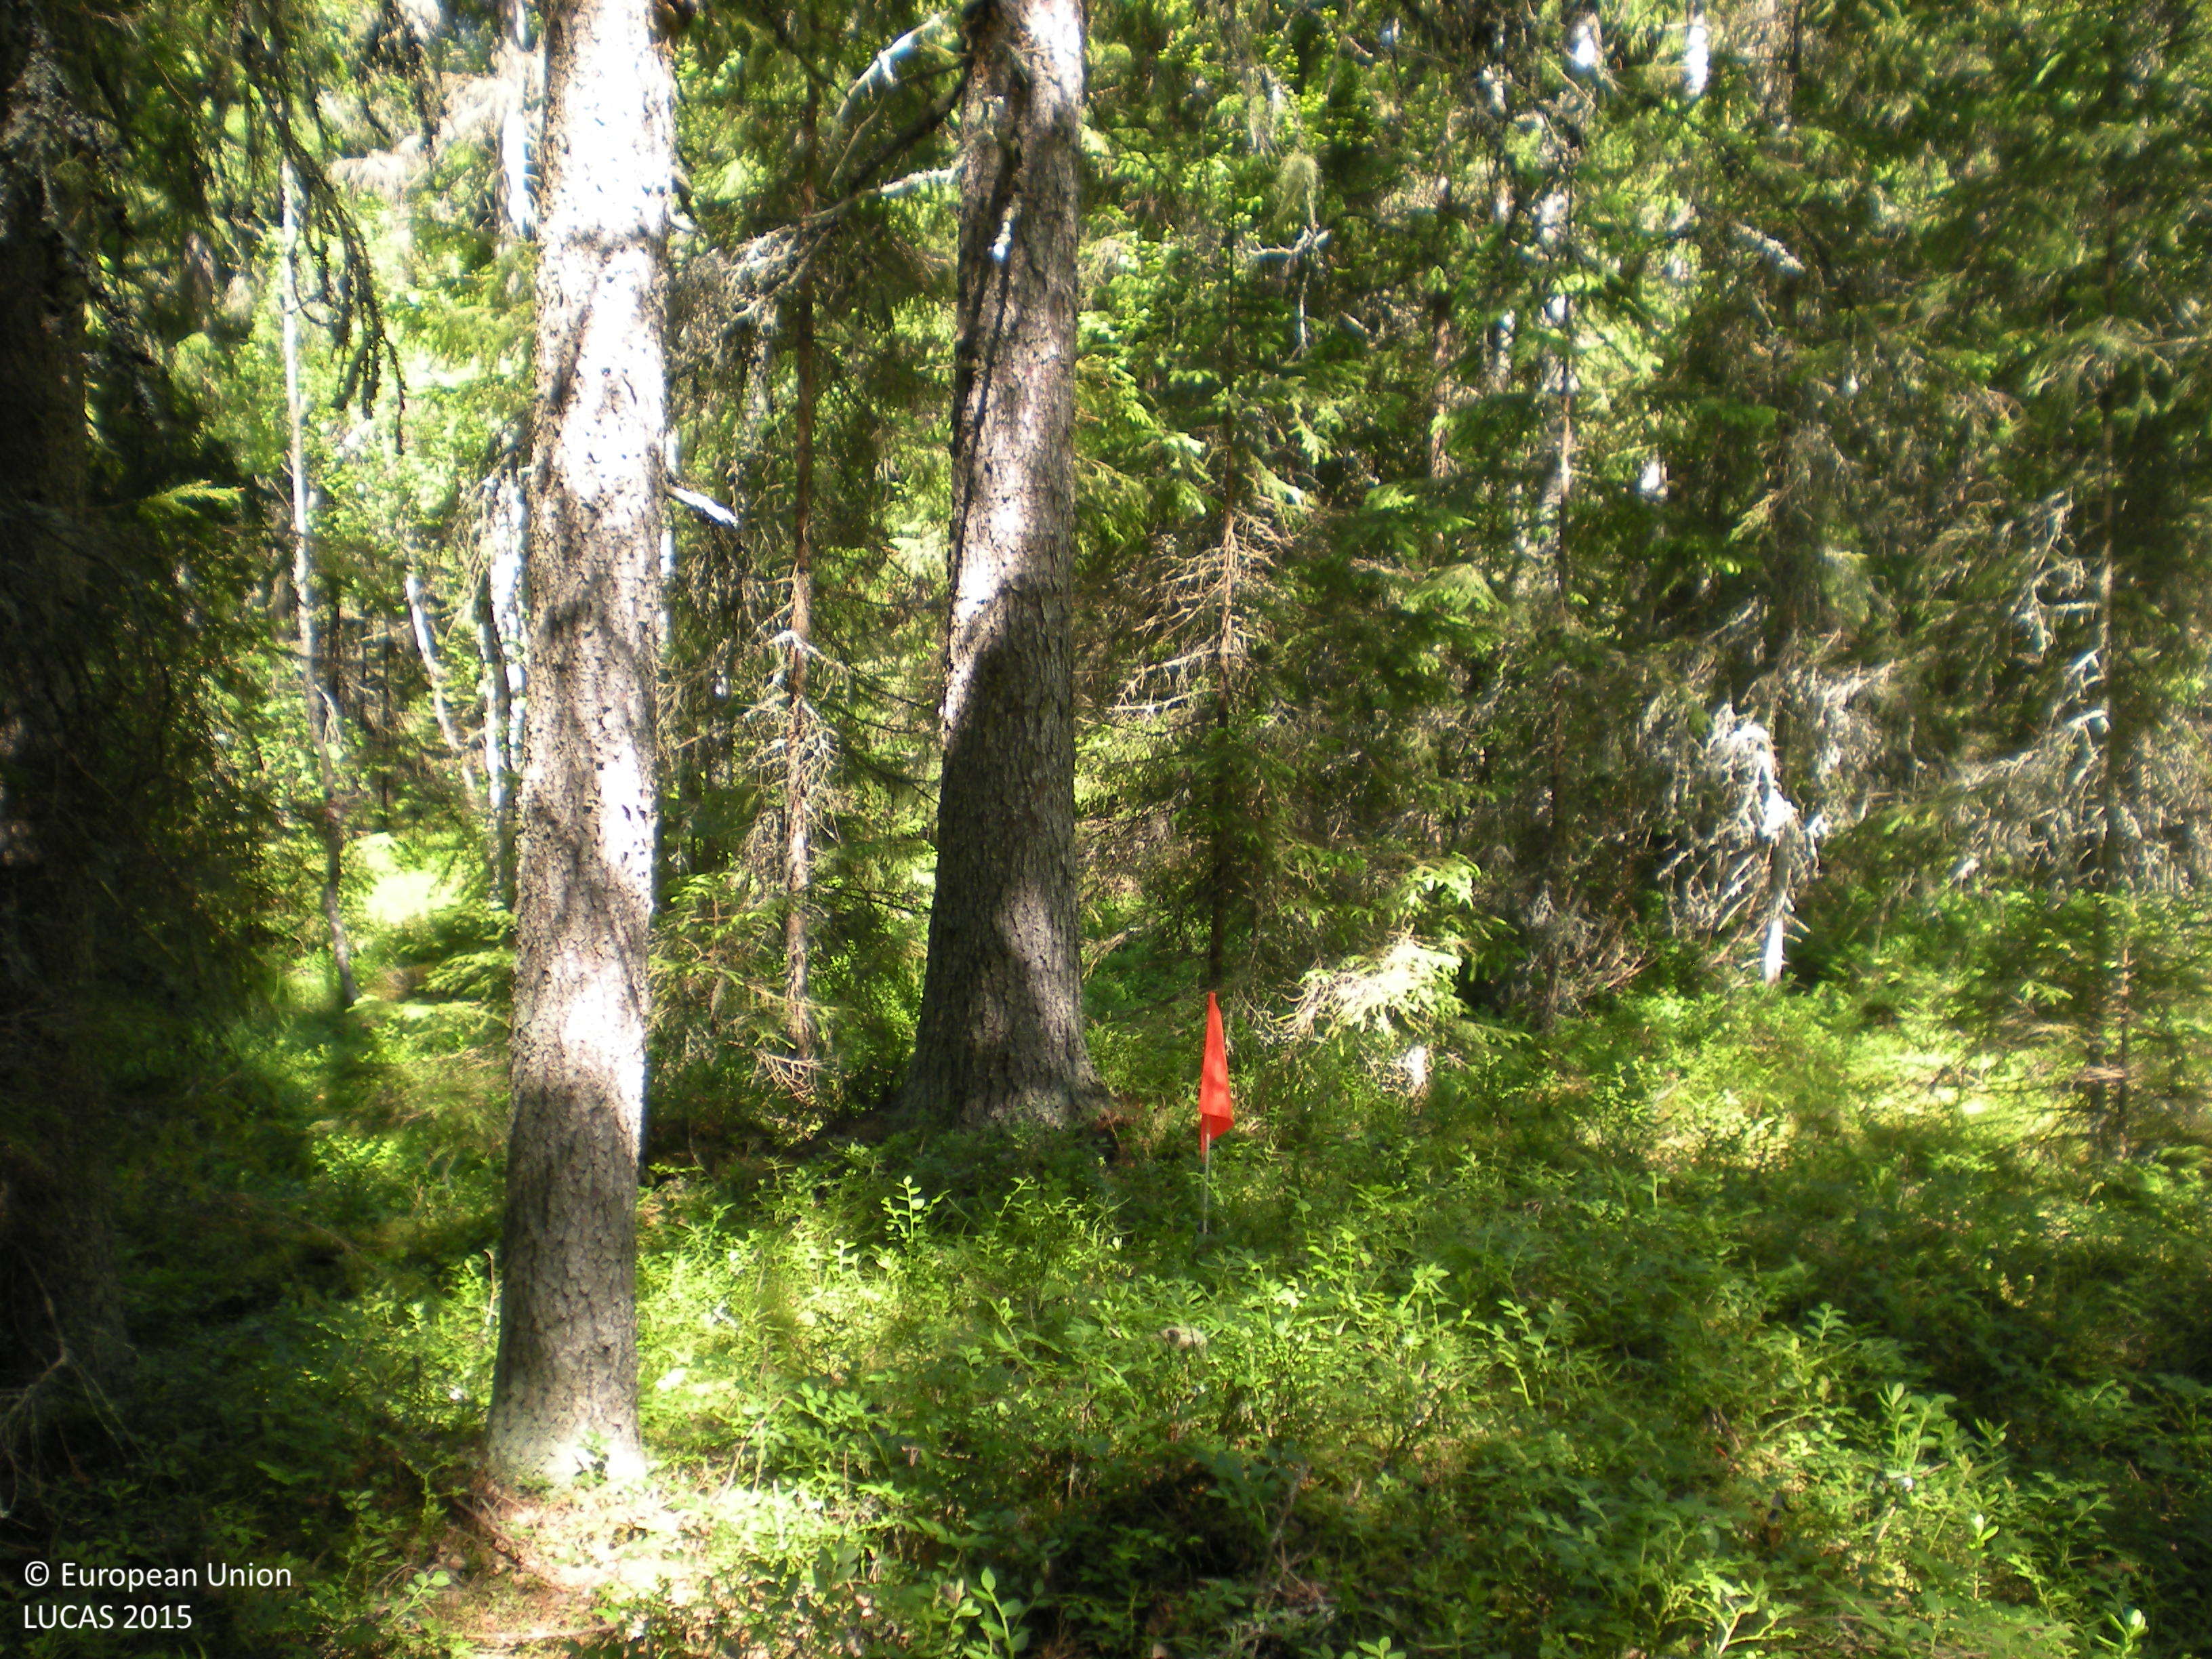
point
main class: Woodland
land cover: Spruce dominated coniferous woodland
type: boreal forest
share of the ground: > 75 %
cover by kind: coniferous forest trees 75 %, shrubs 10 %, lichens and mosses 10 %, broadleaved forest trees 5 %
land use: Amenities, museums, leisure
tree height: > 5 m
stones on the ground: > 50 %
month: June
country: SE
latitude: 60.4934
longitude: 18.0564
